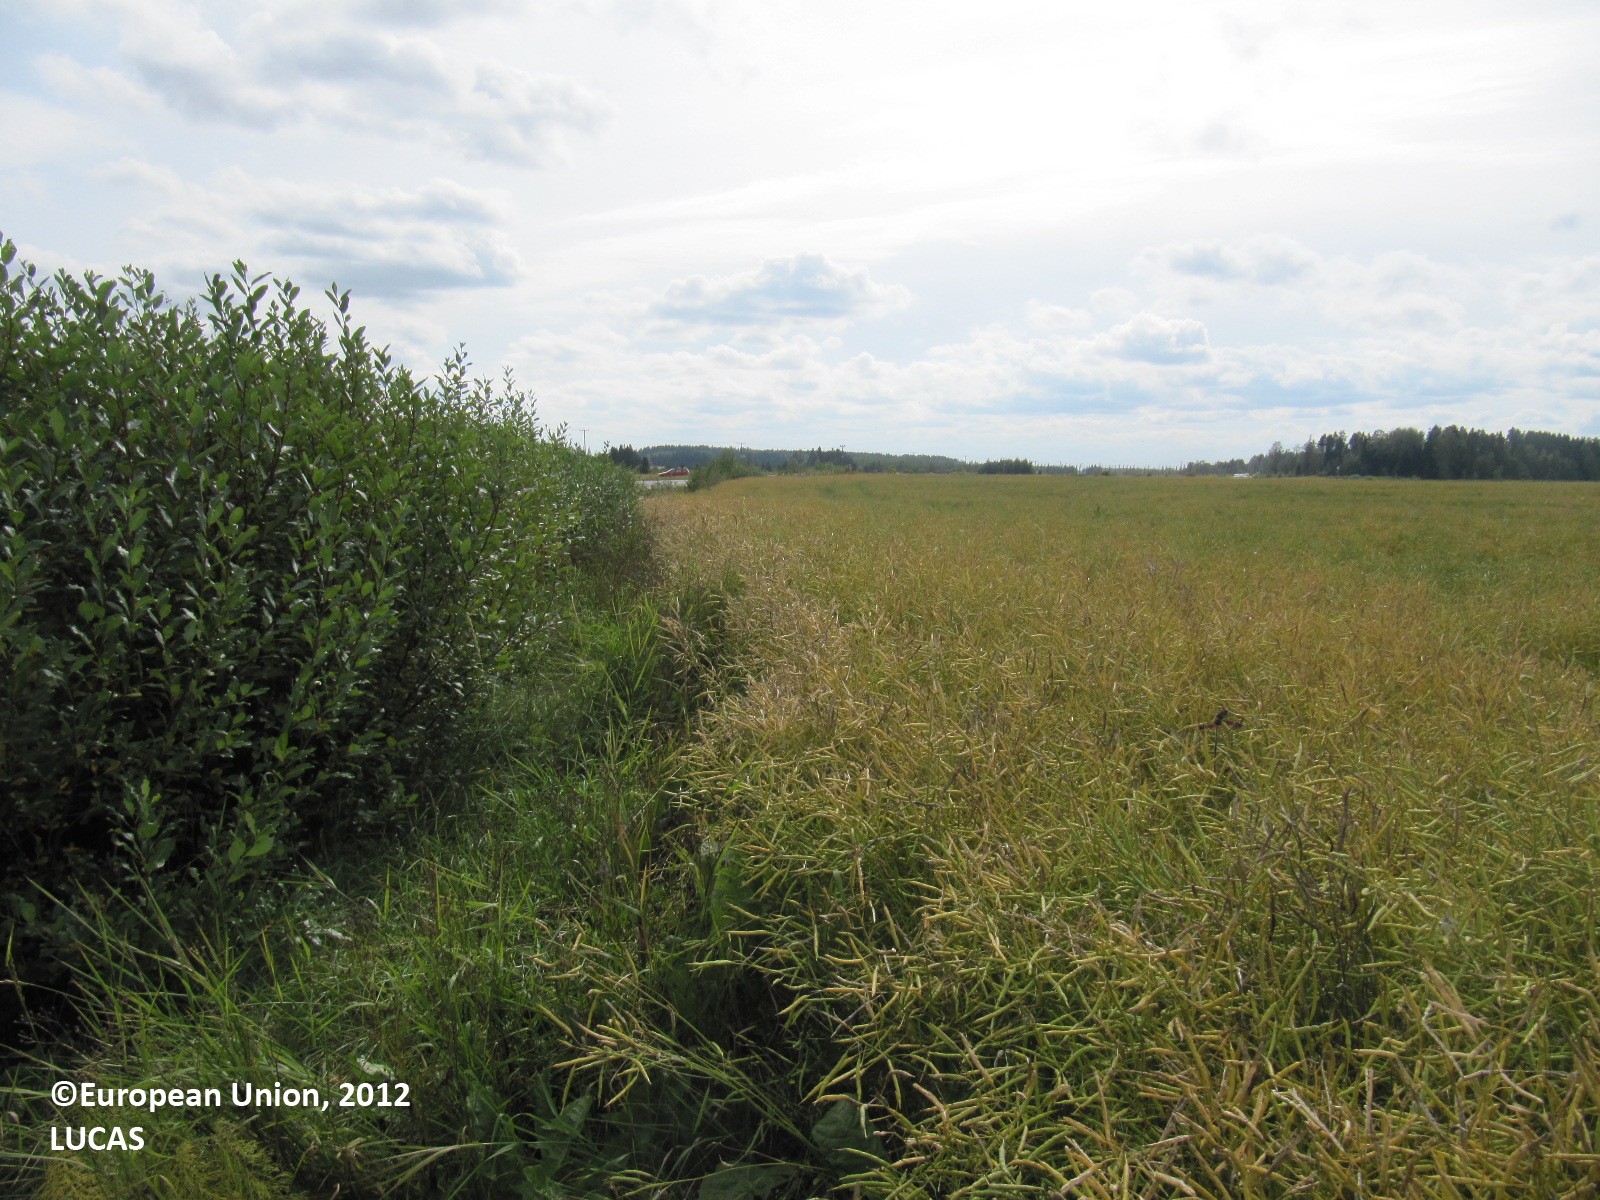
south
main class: Cropland
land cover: Rape and turnip rape
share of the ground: > 75 %
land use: Agriculture (excluding fallow land and kitchen gardens)
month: August
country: FI
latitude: 60.9237
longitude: 22.8564
